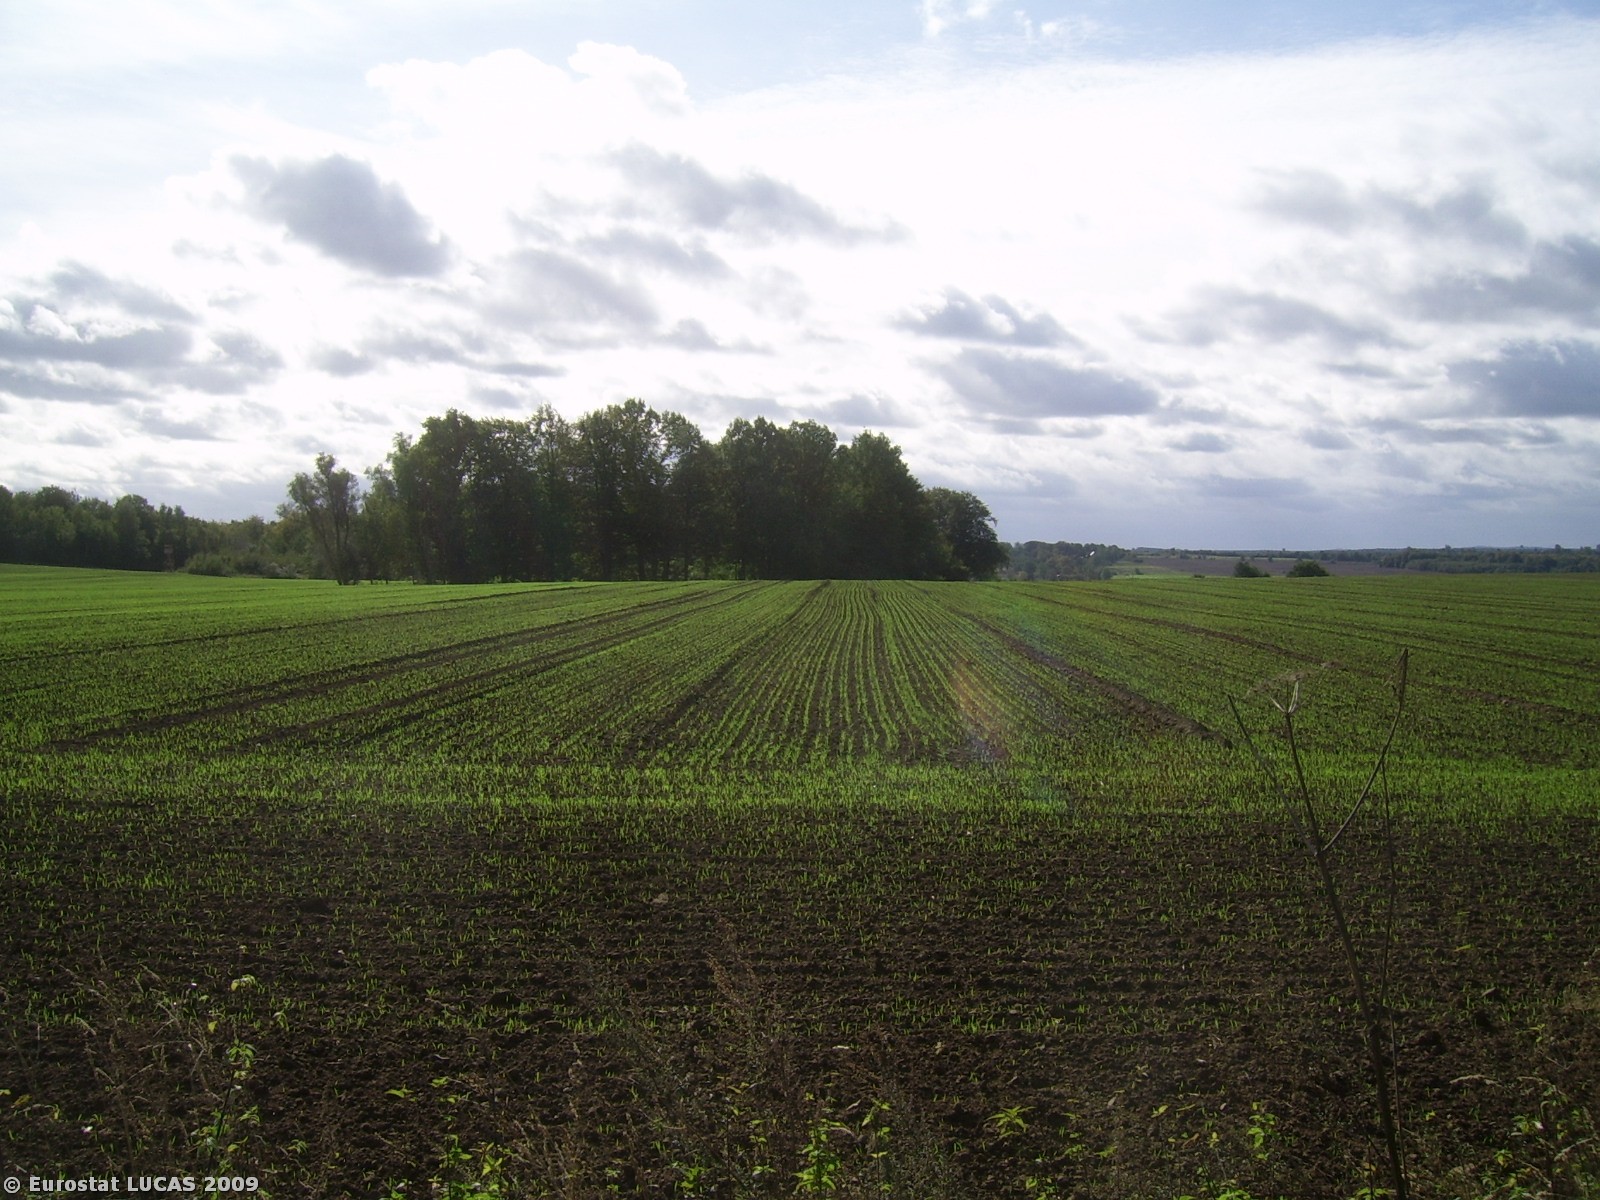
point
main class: Cropland
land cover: Common wheat
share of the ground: < 10 %
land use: Agriculture (excluding fallow land and kitchen gardens)
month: September
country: PL
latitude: 54.3123
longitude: 16.4461
